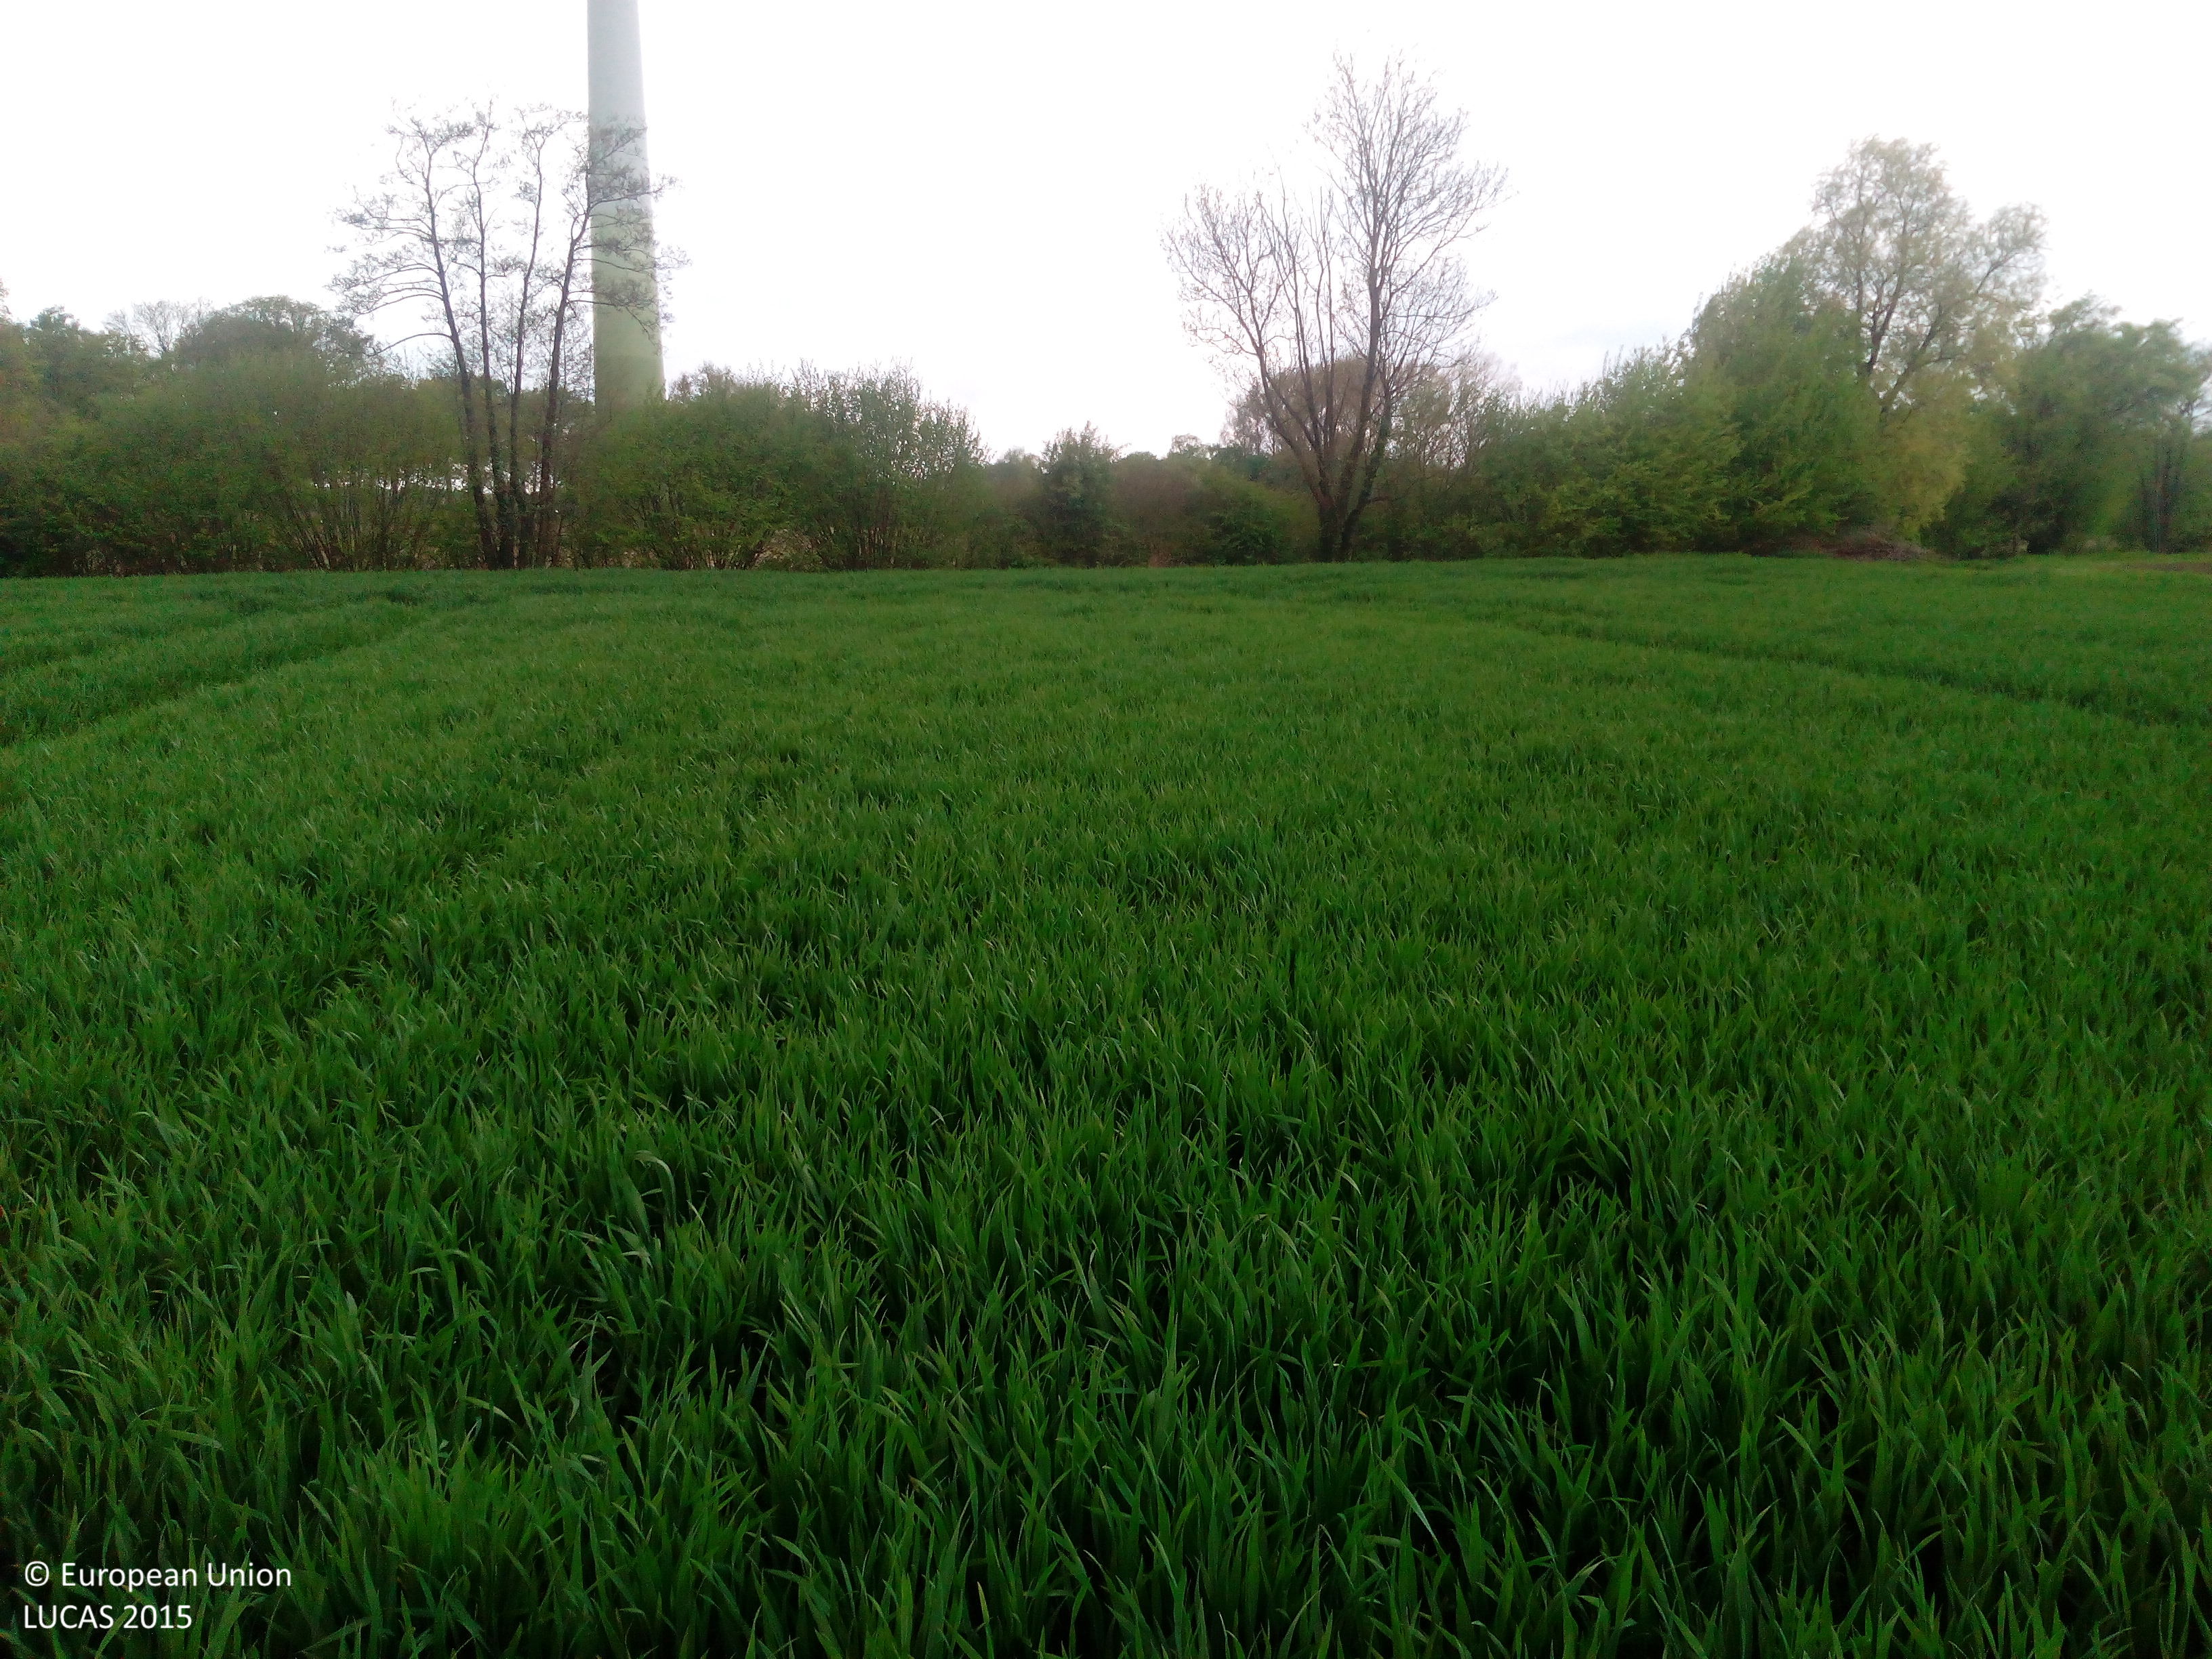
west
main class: Cropland
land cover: Triticale
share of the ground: > 75 %
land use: Agriculture (excluding fallow land and kitchen gardens)
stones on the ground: < 10 %
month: May
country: DE
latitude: 51.8635
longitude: 7.4009
